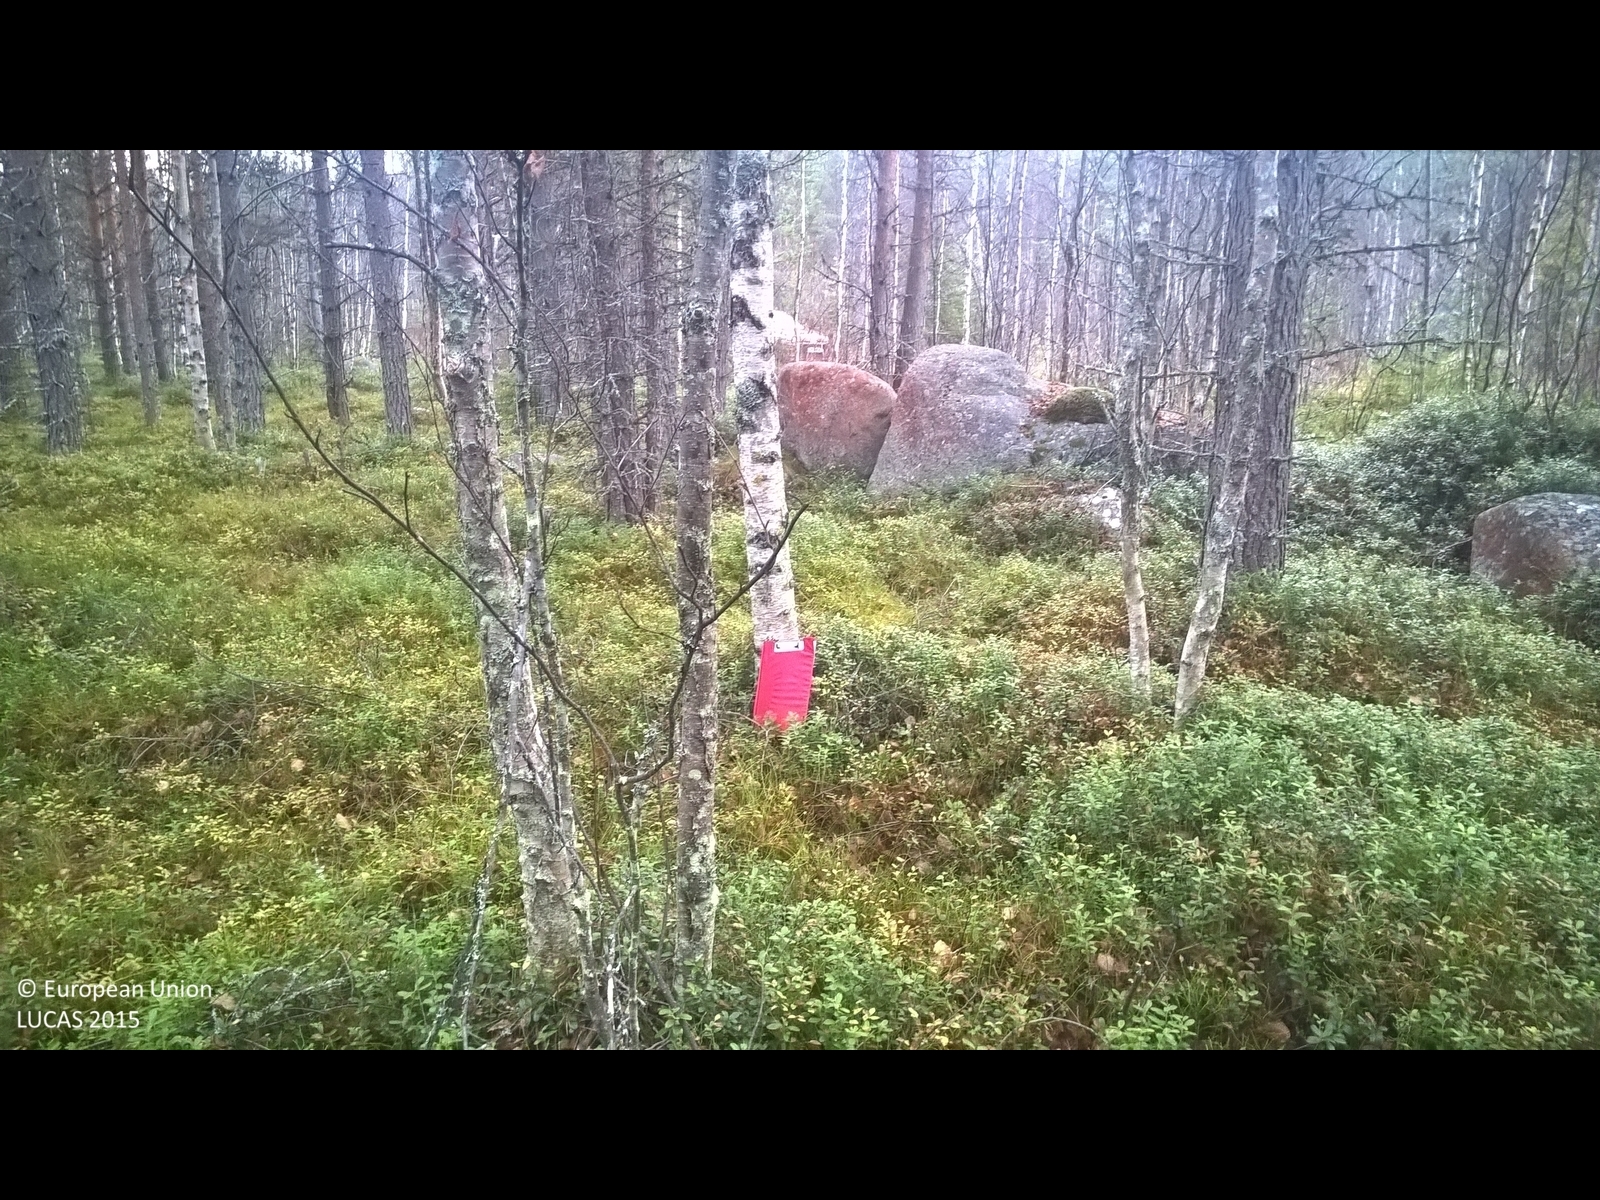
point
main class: Woodland
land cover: Pine dominated mixed woodland
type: boreal forest
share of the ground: > 75 %
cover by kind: coniferous forest trees 40 %, broadleaved forest trees 40 %, shrubs 20 %
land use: Forestry
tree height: > 5 m
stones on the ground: < 10 %
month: October
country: SE
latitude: 65.1294
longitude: 17.8685
